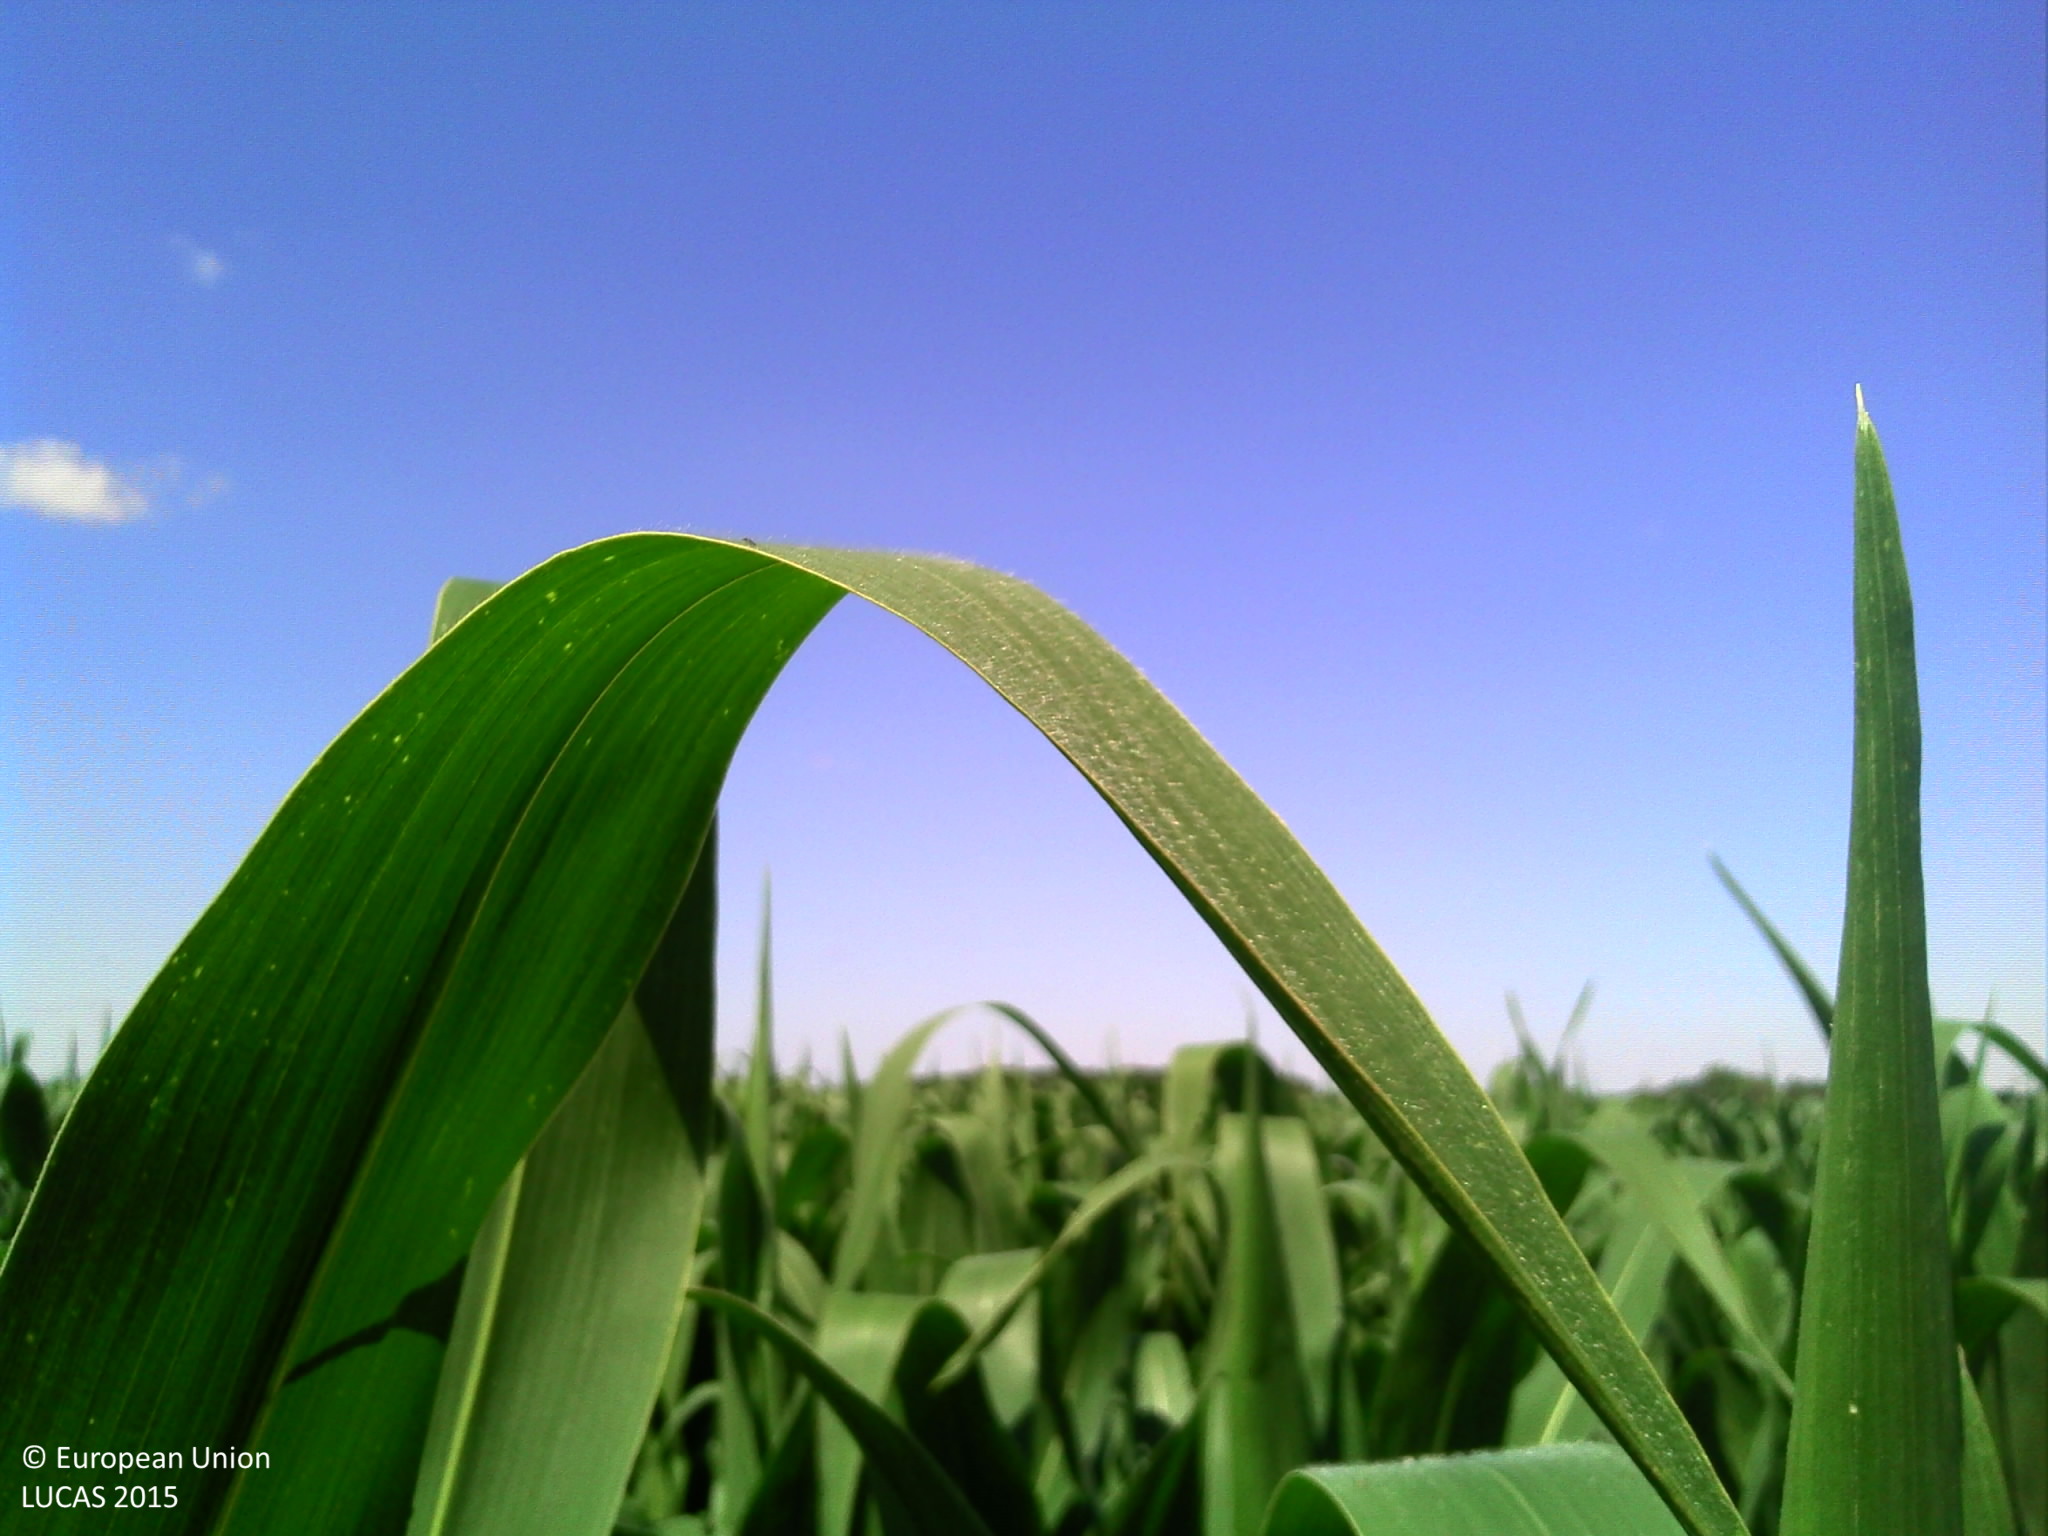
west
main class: Cropland
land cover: Maize
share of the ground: > 75 %
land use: Agriculture (excluding fallow land and kitchen gardens)
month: July
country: FR
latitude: 48.0229
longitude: 3.0610
